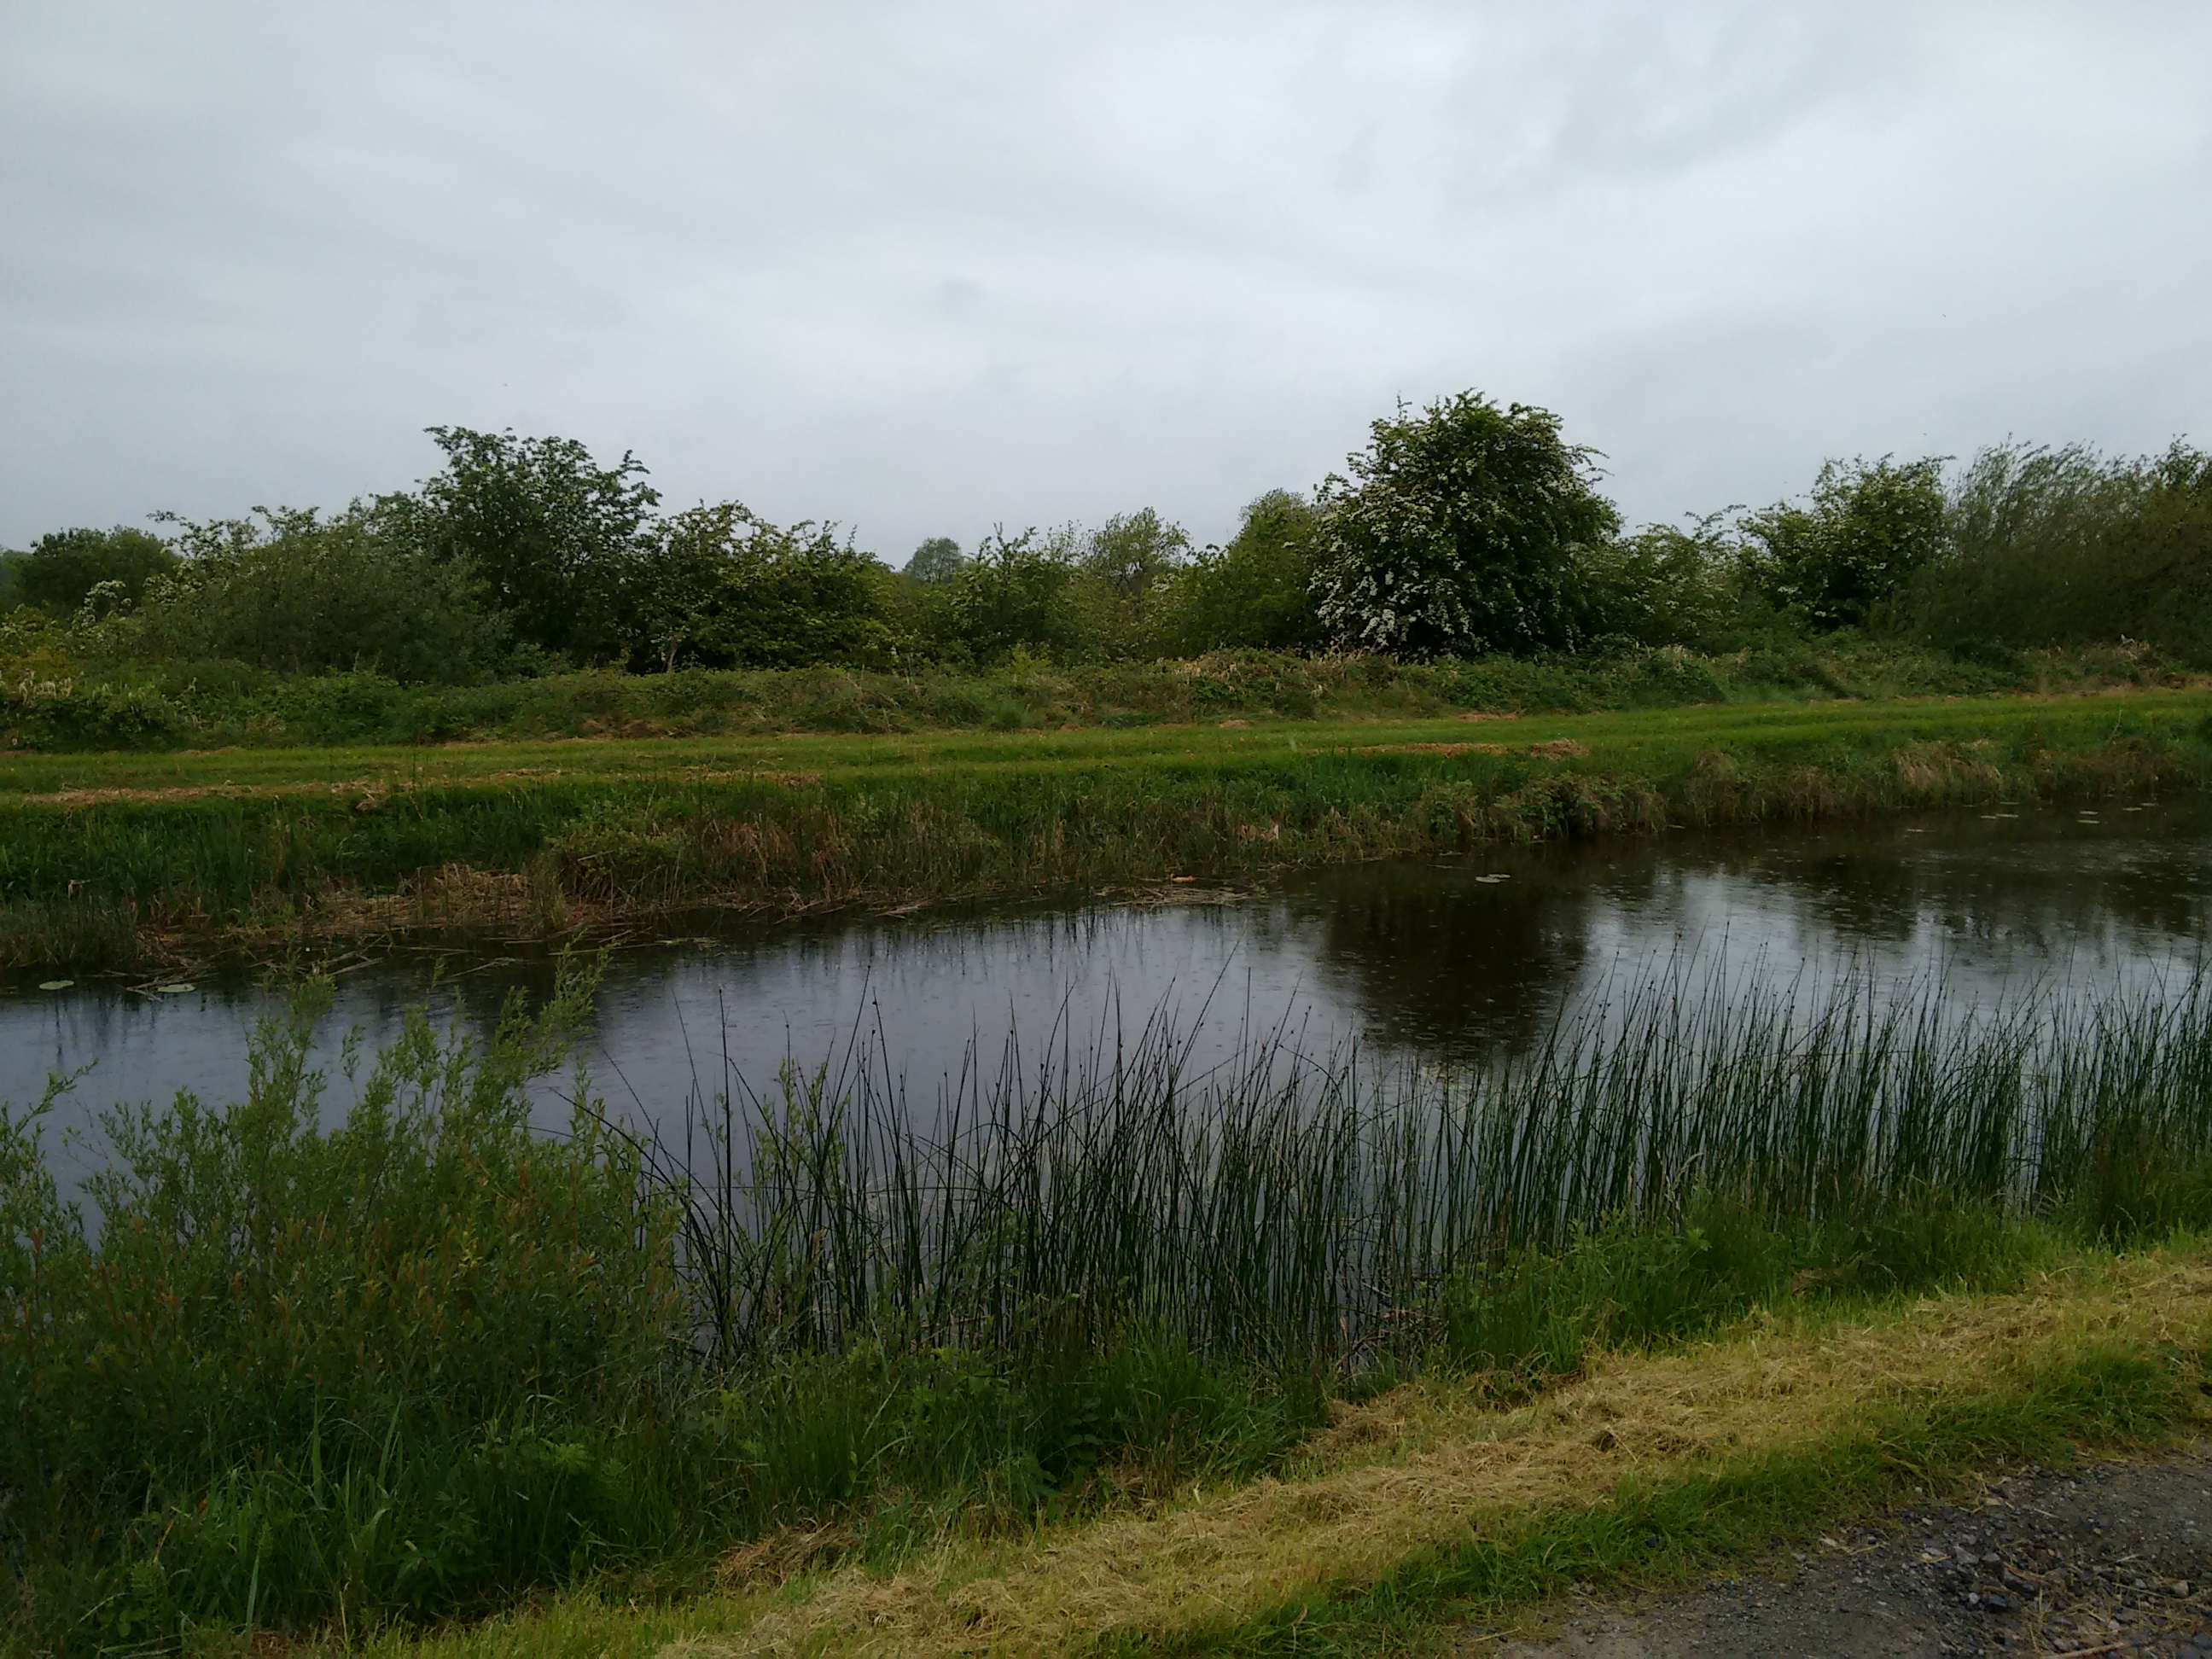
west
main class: Grassland
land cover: Grassland without tree/shrub cover
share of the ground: > 75 %
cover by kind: herbaceous plants 95 %, unconsolidated bare surface 5 %
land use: Agriculture (excluding fallow land and kitchen gardens)
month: May
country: IE
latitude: 53.4616
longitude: -6.9649
